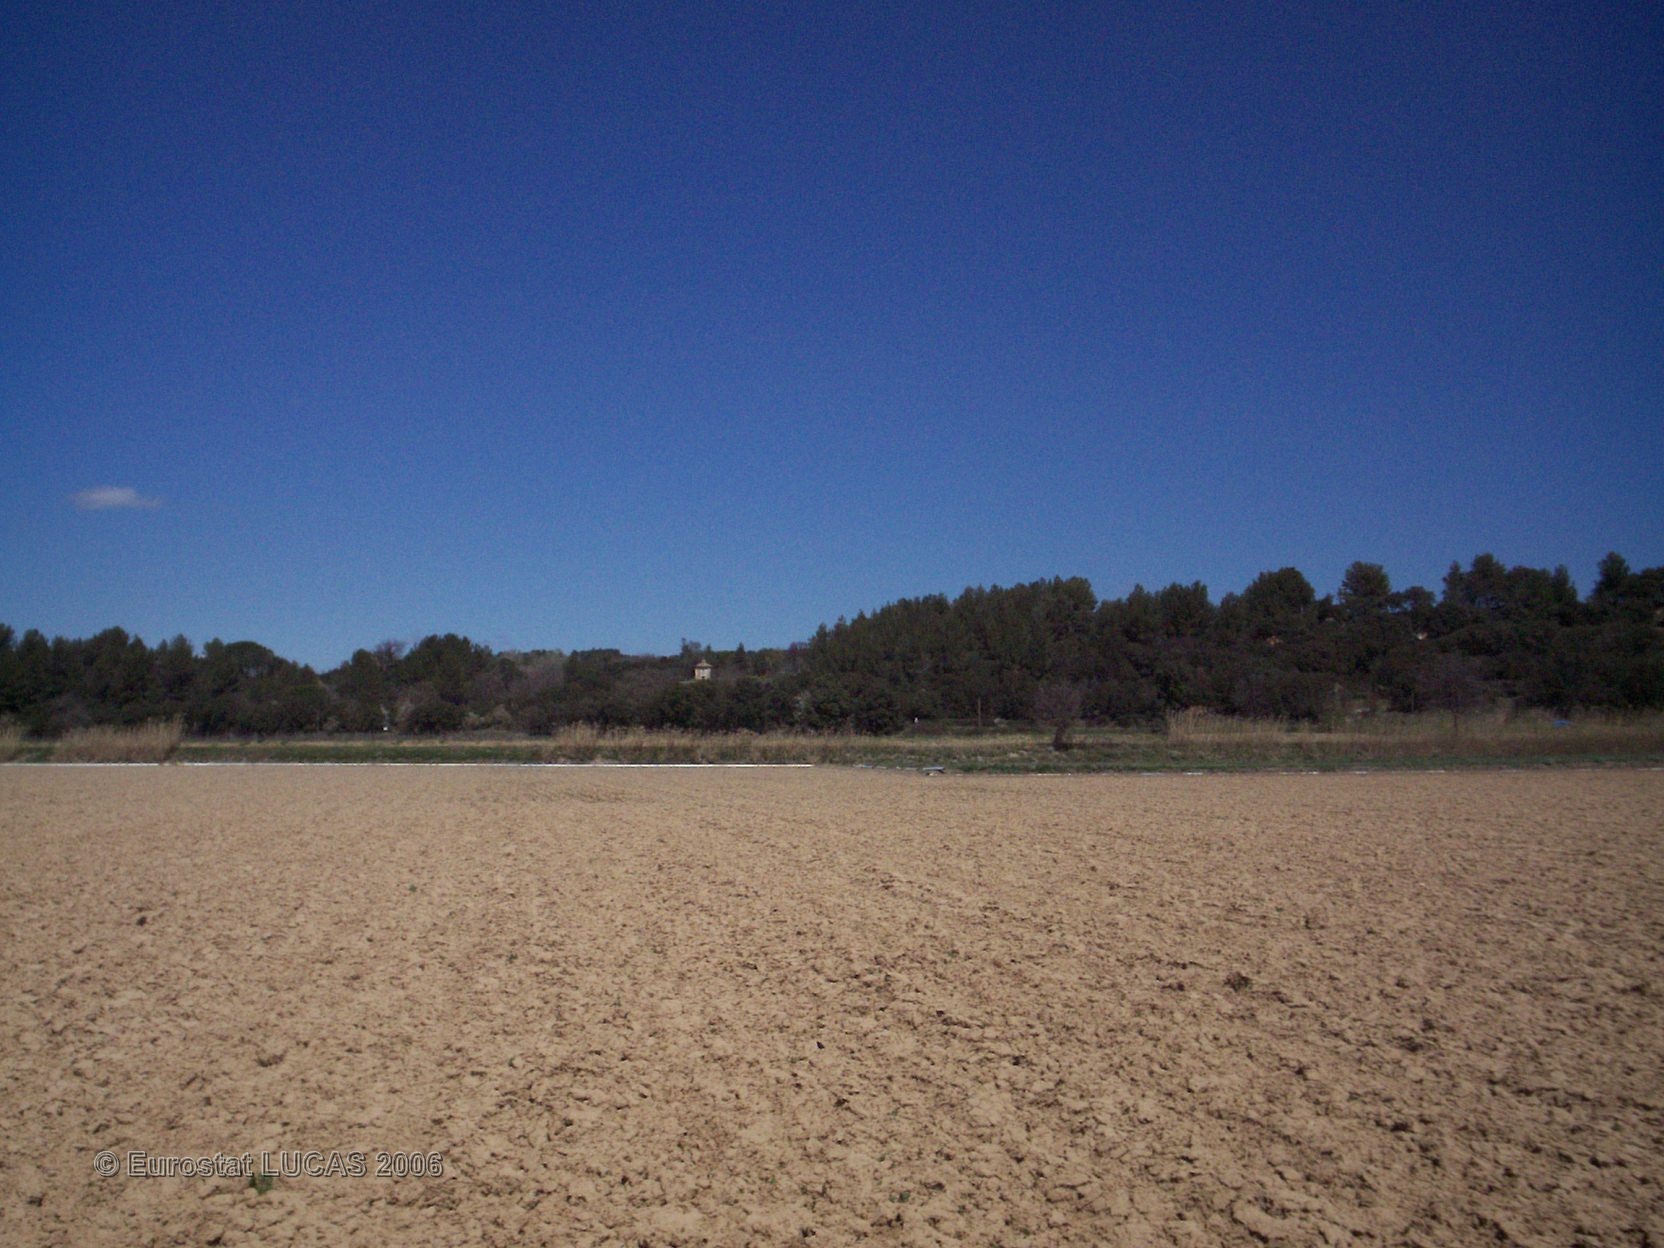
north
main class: Cropland
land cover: Maize
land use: Agriculture (excluding fallow land and kitchen gardens)
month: June
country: FR
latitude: 43.6762
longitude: 5.5315
